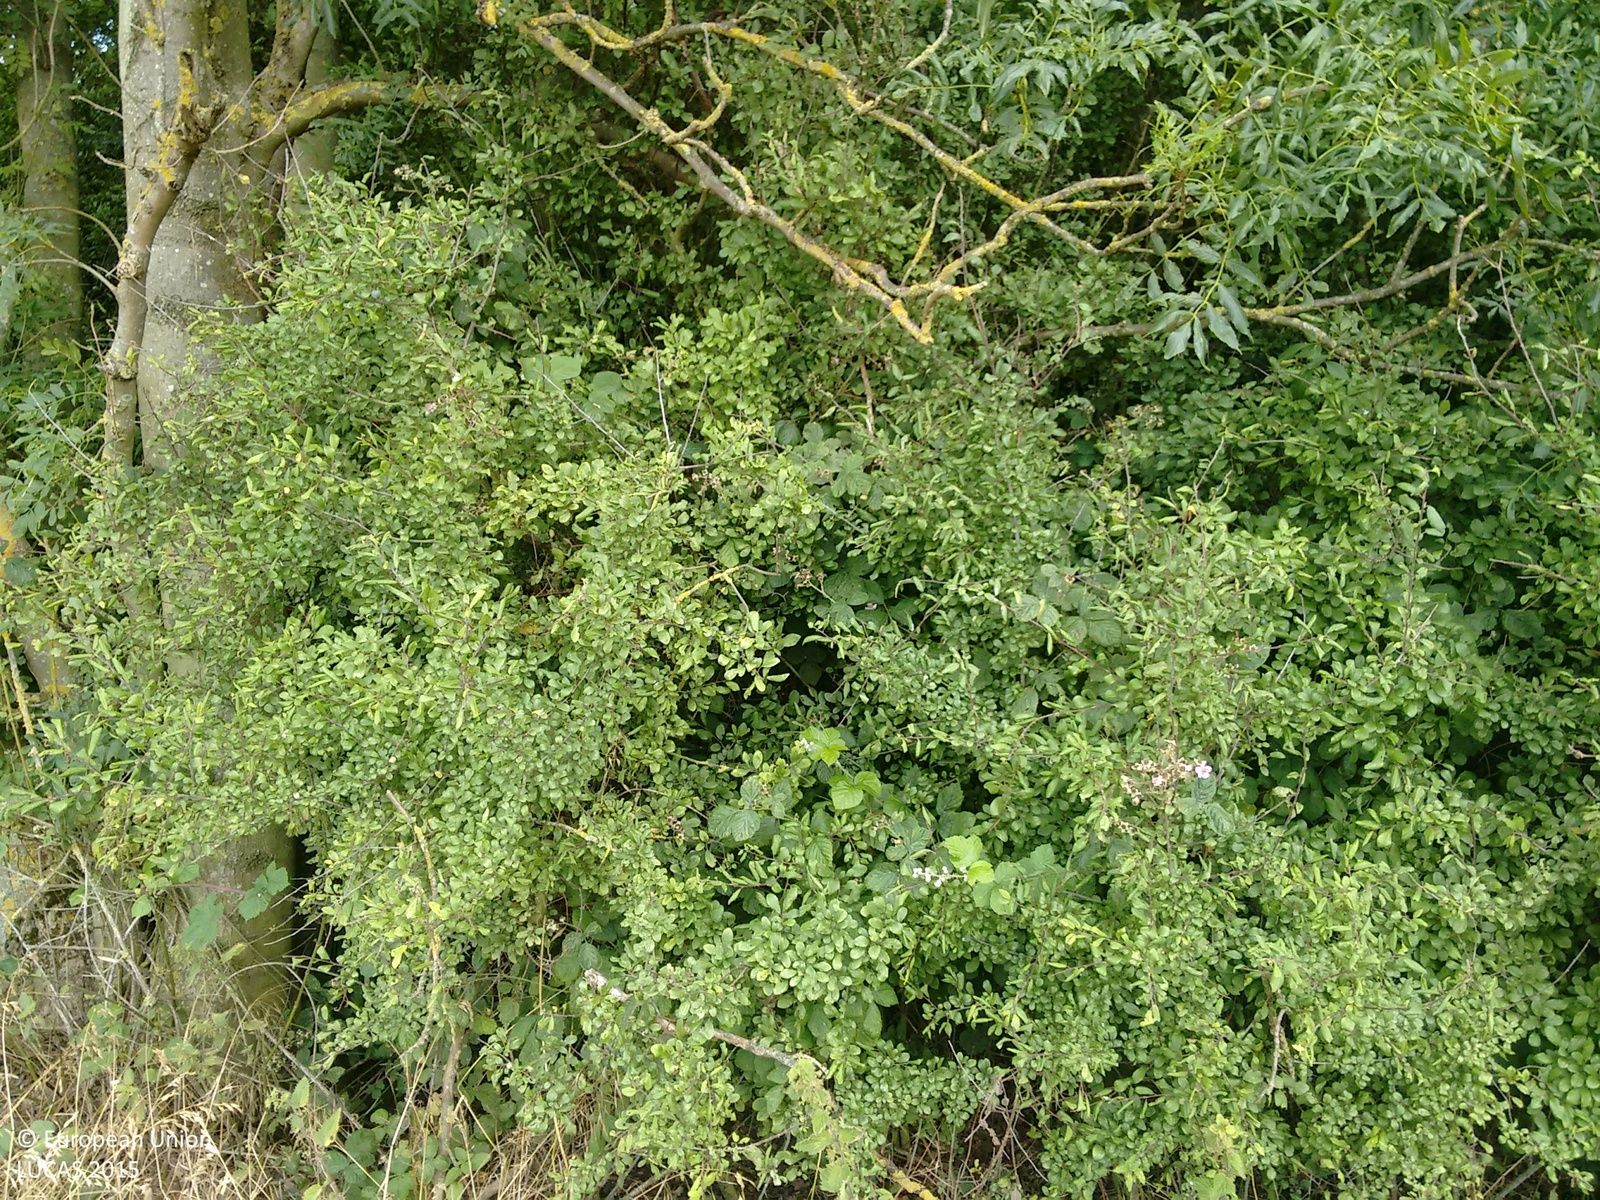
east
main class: Cropland
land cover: Common wheat
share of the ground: > 75 %
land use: Agriculture (excluding fallow land and kitchen gardens)
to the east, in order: Ditches and canals; Shrubland with sparse tree cover; Grass margins; Paved roads, cycling and walking lanes; Grass margins; Managed hedges; Grassland with sparse tree/shrub cover; Abandoned hedges; Electric lines; Grassland without tree/shrub cover; Electric lines; Fences; Grassland without tree/shrub cover; Fences; Abandoned hedges; Ditches and canals; Grass margins; Tracks; Grass margins; Ditches and canals; Abandoned hedges; Fences; Grassland without tree/shrub cover
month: July
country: GB
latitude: 51.9346
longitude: 0.4156
